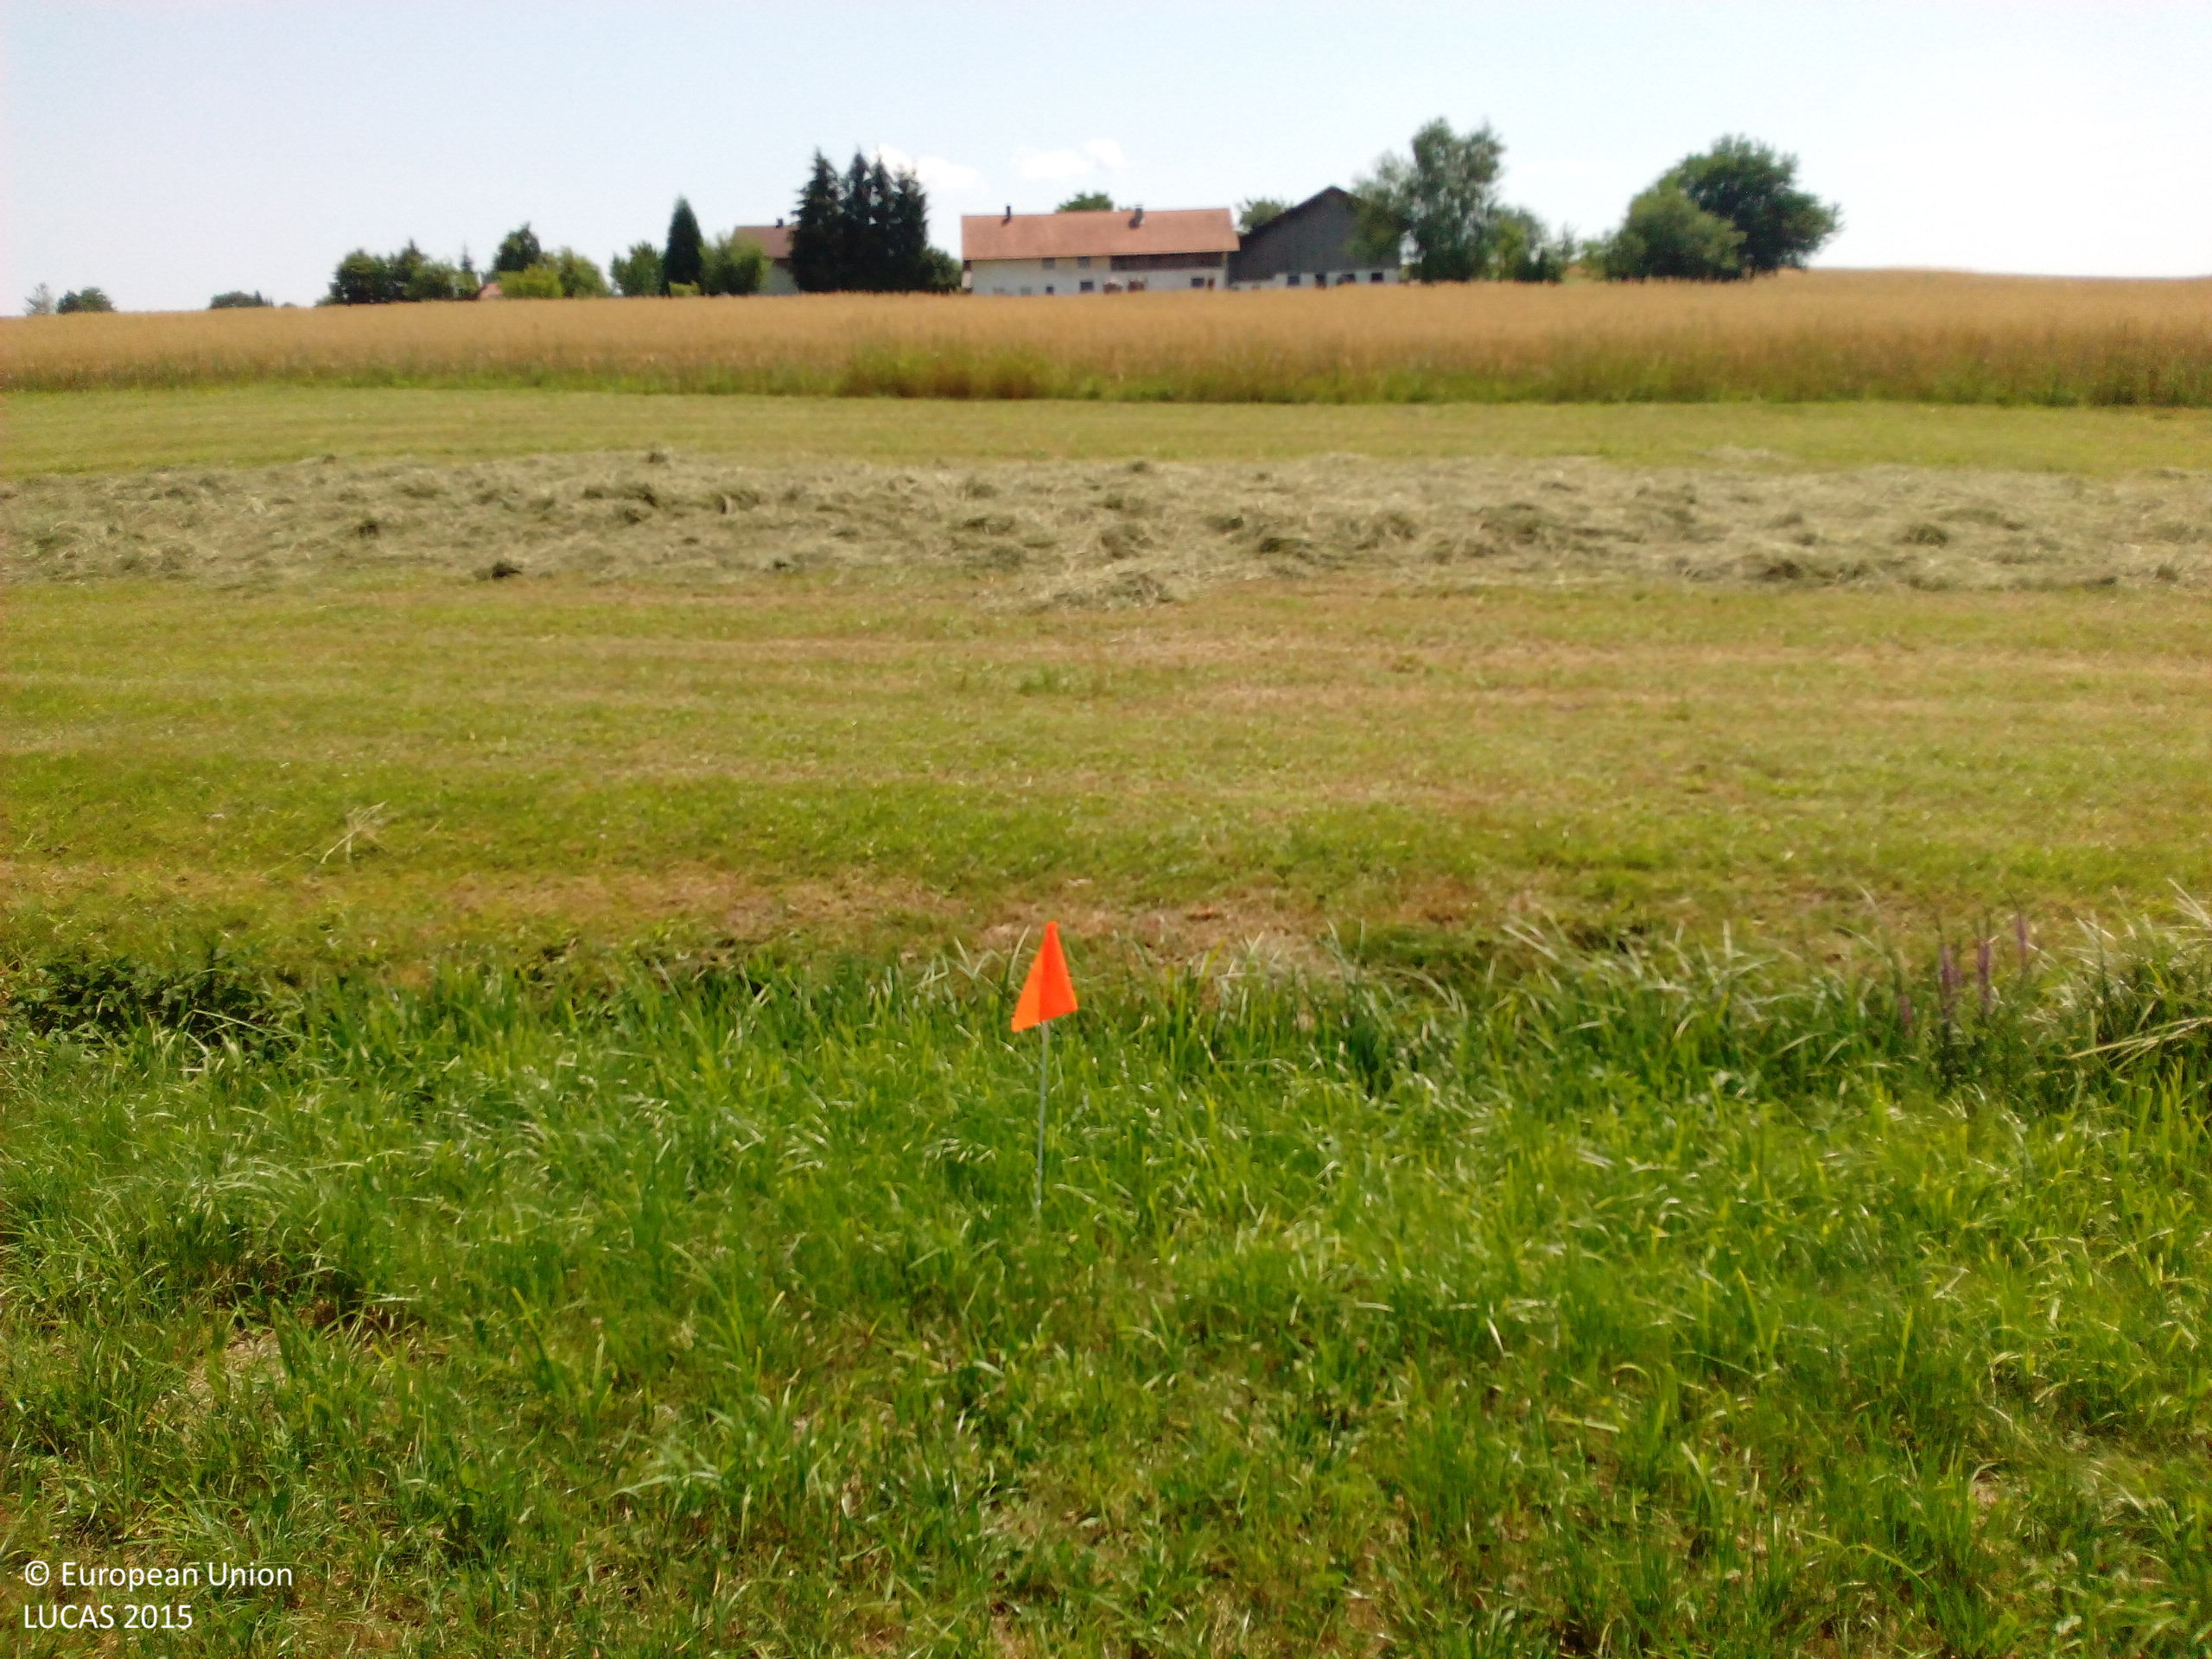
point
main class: Grassland
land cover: Grassland without tree/shrub cover
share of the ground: 50 - 75 %
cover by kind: herbaceous plants 70 %, unconsolidated bare surface 30 %
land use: Agriculture (excluding fallow land and kitchen gardens)
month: July
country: DE
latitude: 48.4733
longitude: 12.9074
